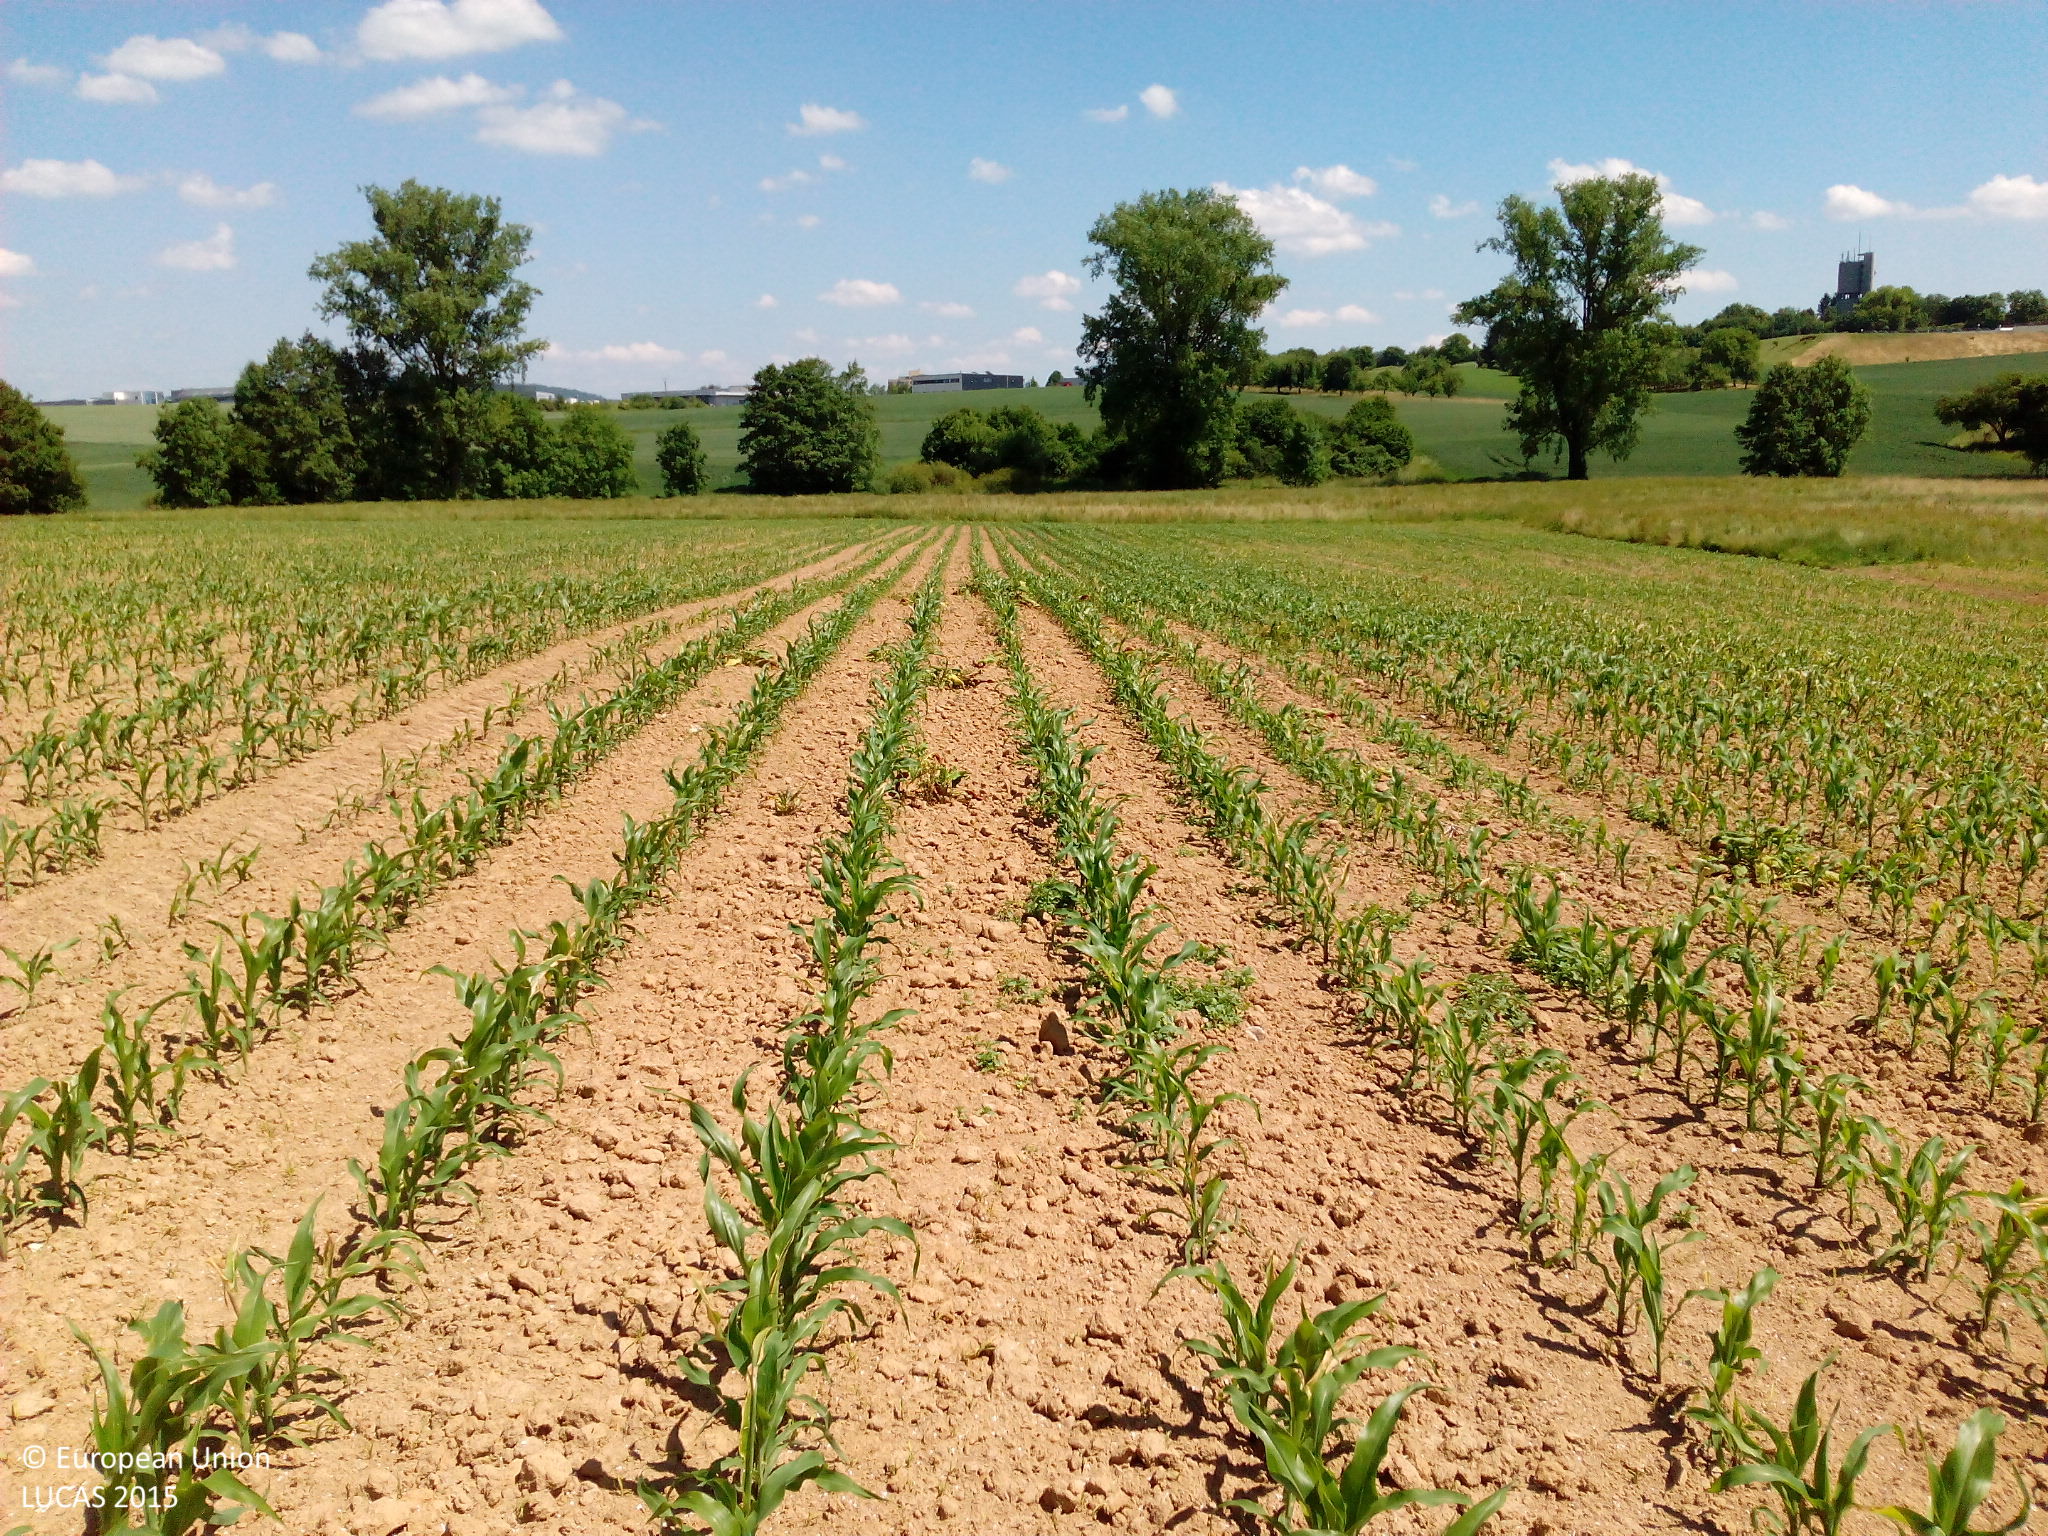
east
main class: Cropland
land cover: Maize
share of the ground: 10 - 25 %
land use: Agriculture (excluding fallow land and kitchen gardens)
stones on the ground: < 10 %
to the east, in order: Maize; Grassland without tree/shrub cover; Abandoned hedges; Ditches and canals; Grassland without tree/shrub cover; Common wheat; Tracks; Common wheat
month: June
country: DE
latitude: 48.9597
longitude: 9.4130
